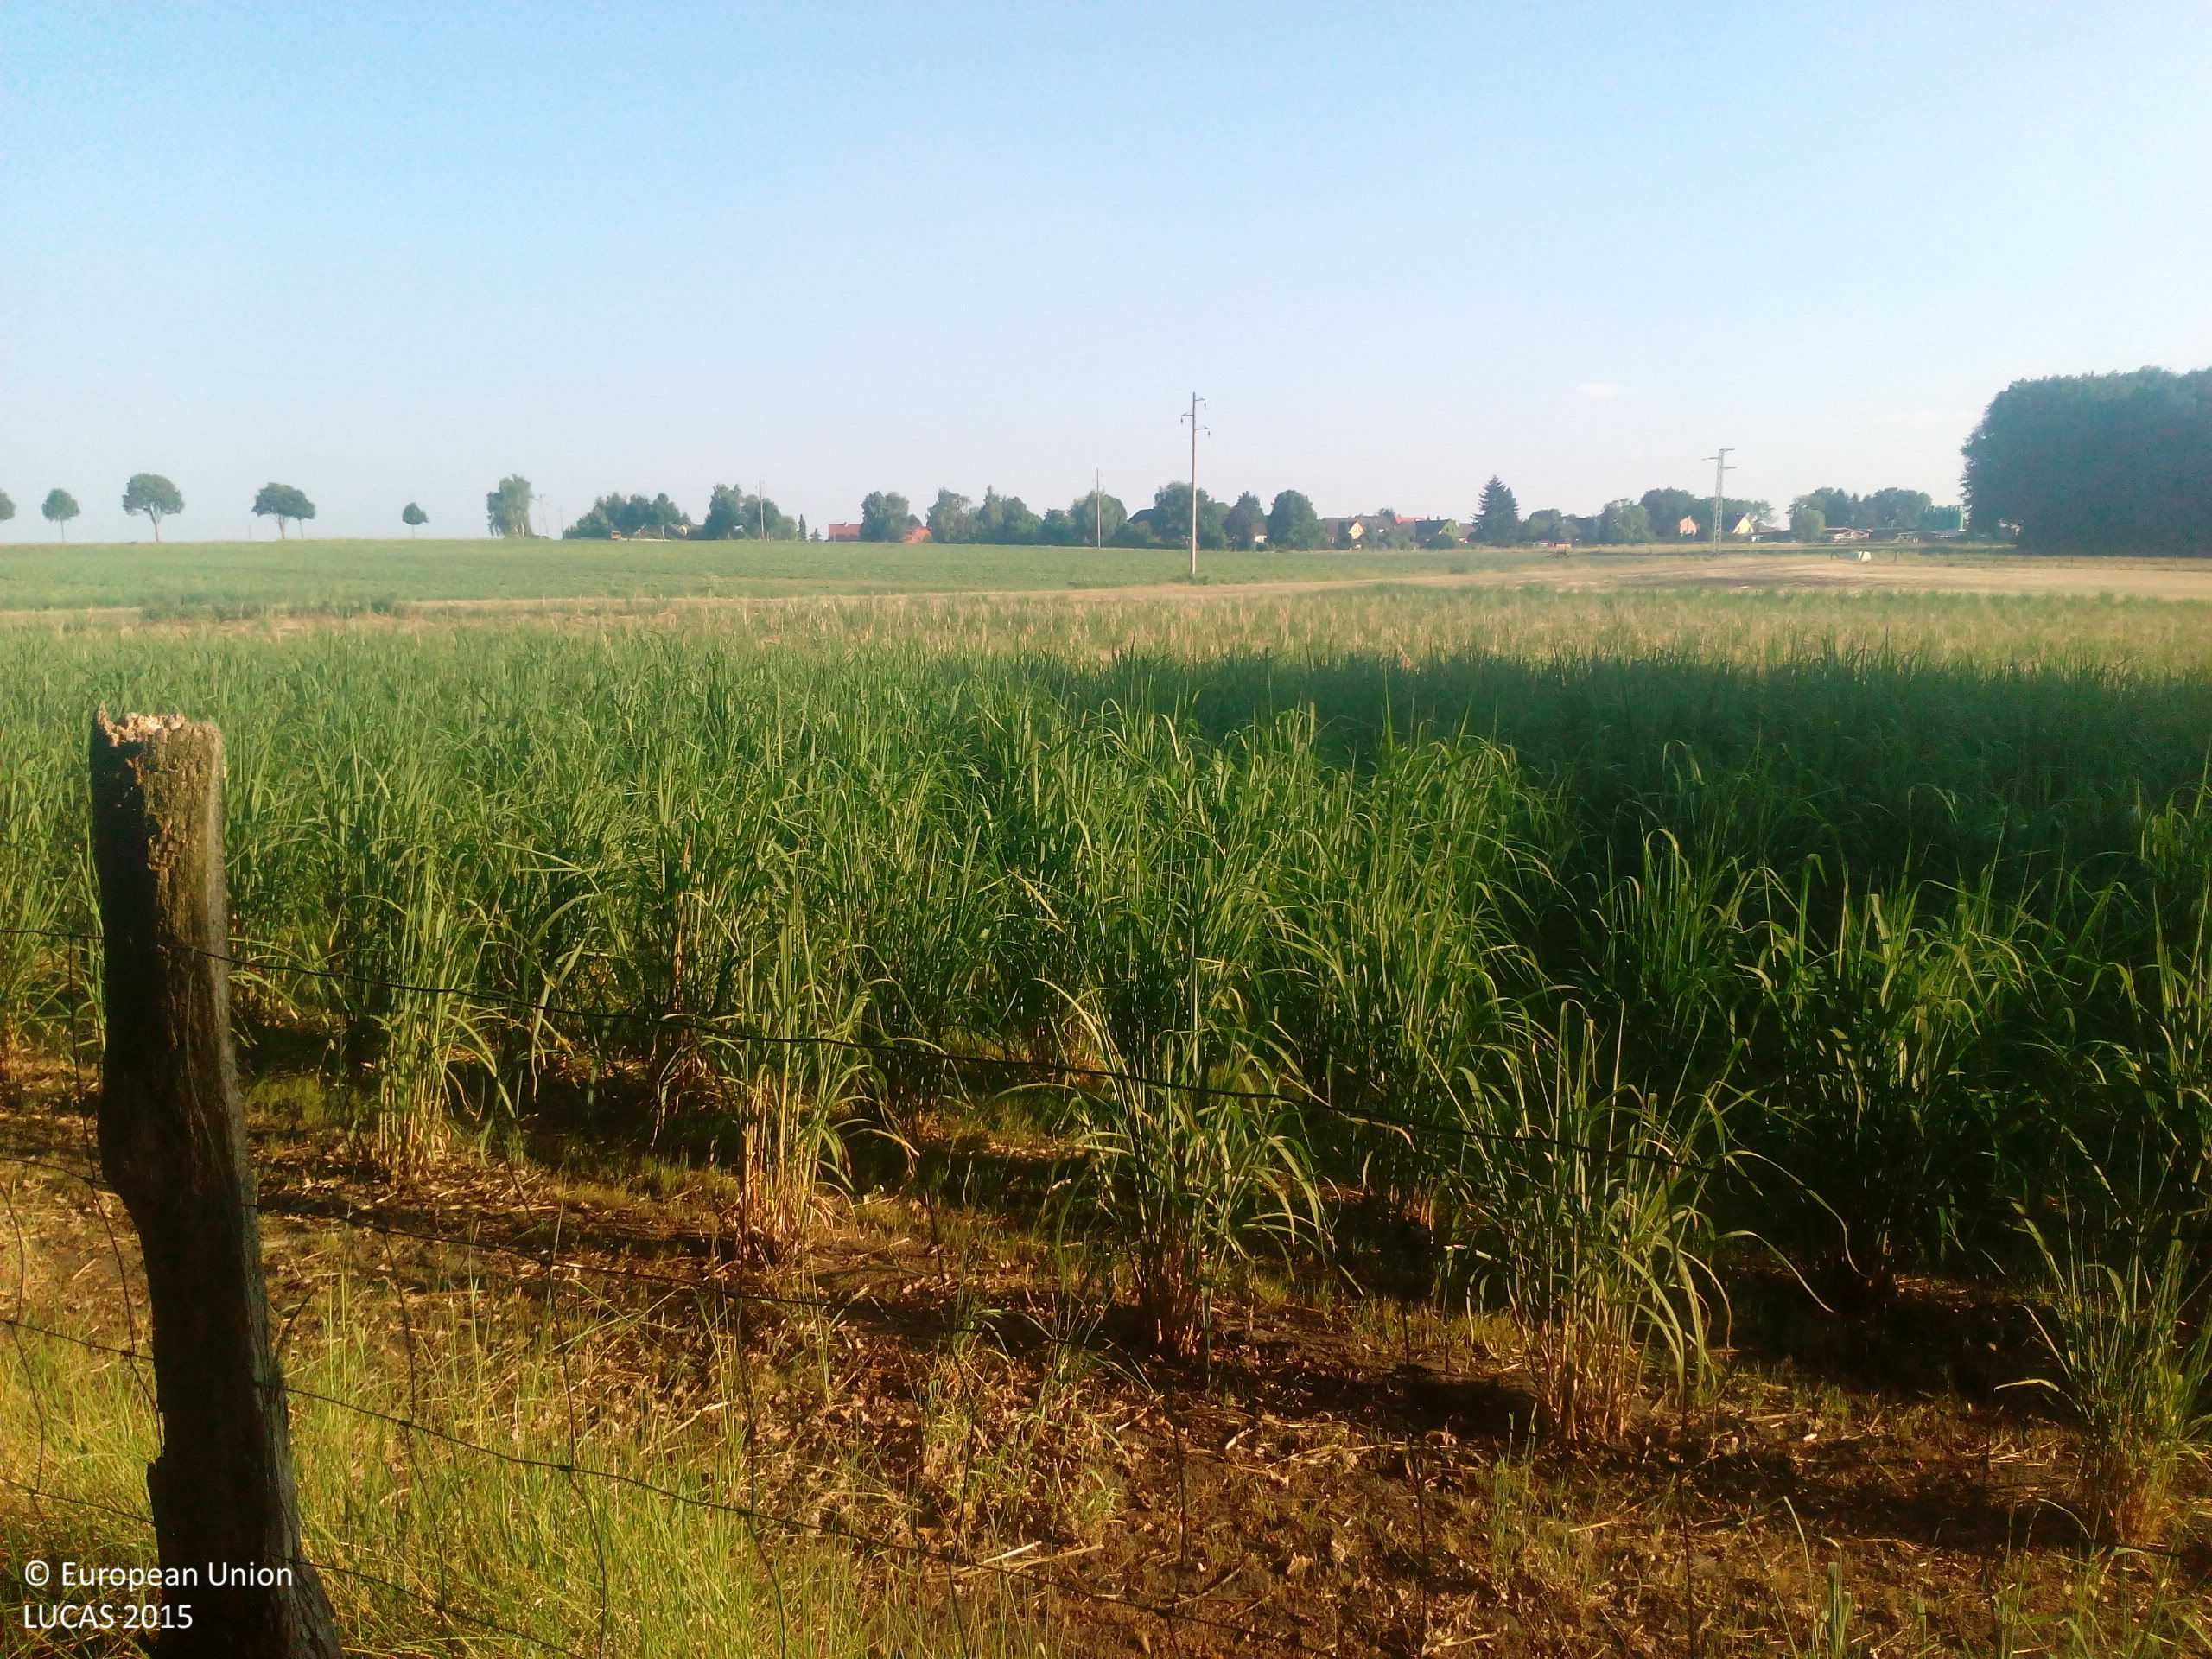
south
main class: Woodland
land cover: Broadleaved woodland
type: acidophilous oak and oak-birch forest
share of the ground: > 75 %
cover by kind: broadleaved forest trees 100 %
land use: Forestry
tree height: > 5 m
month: June
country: DE
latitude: 52.5196
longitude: 10.6335
